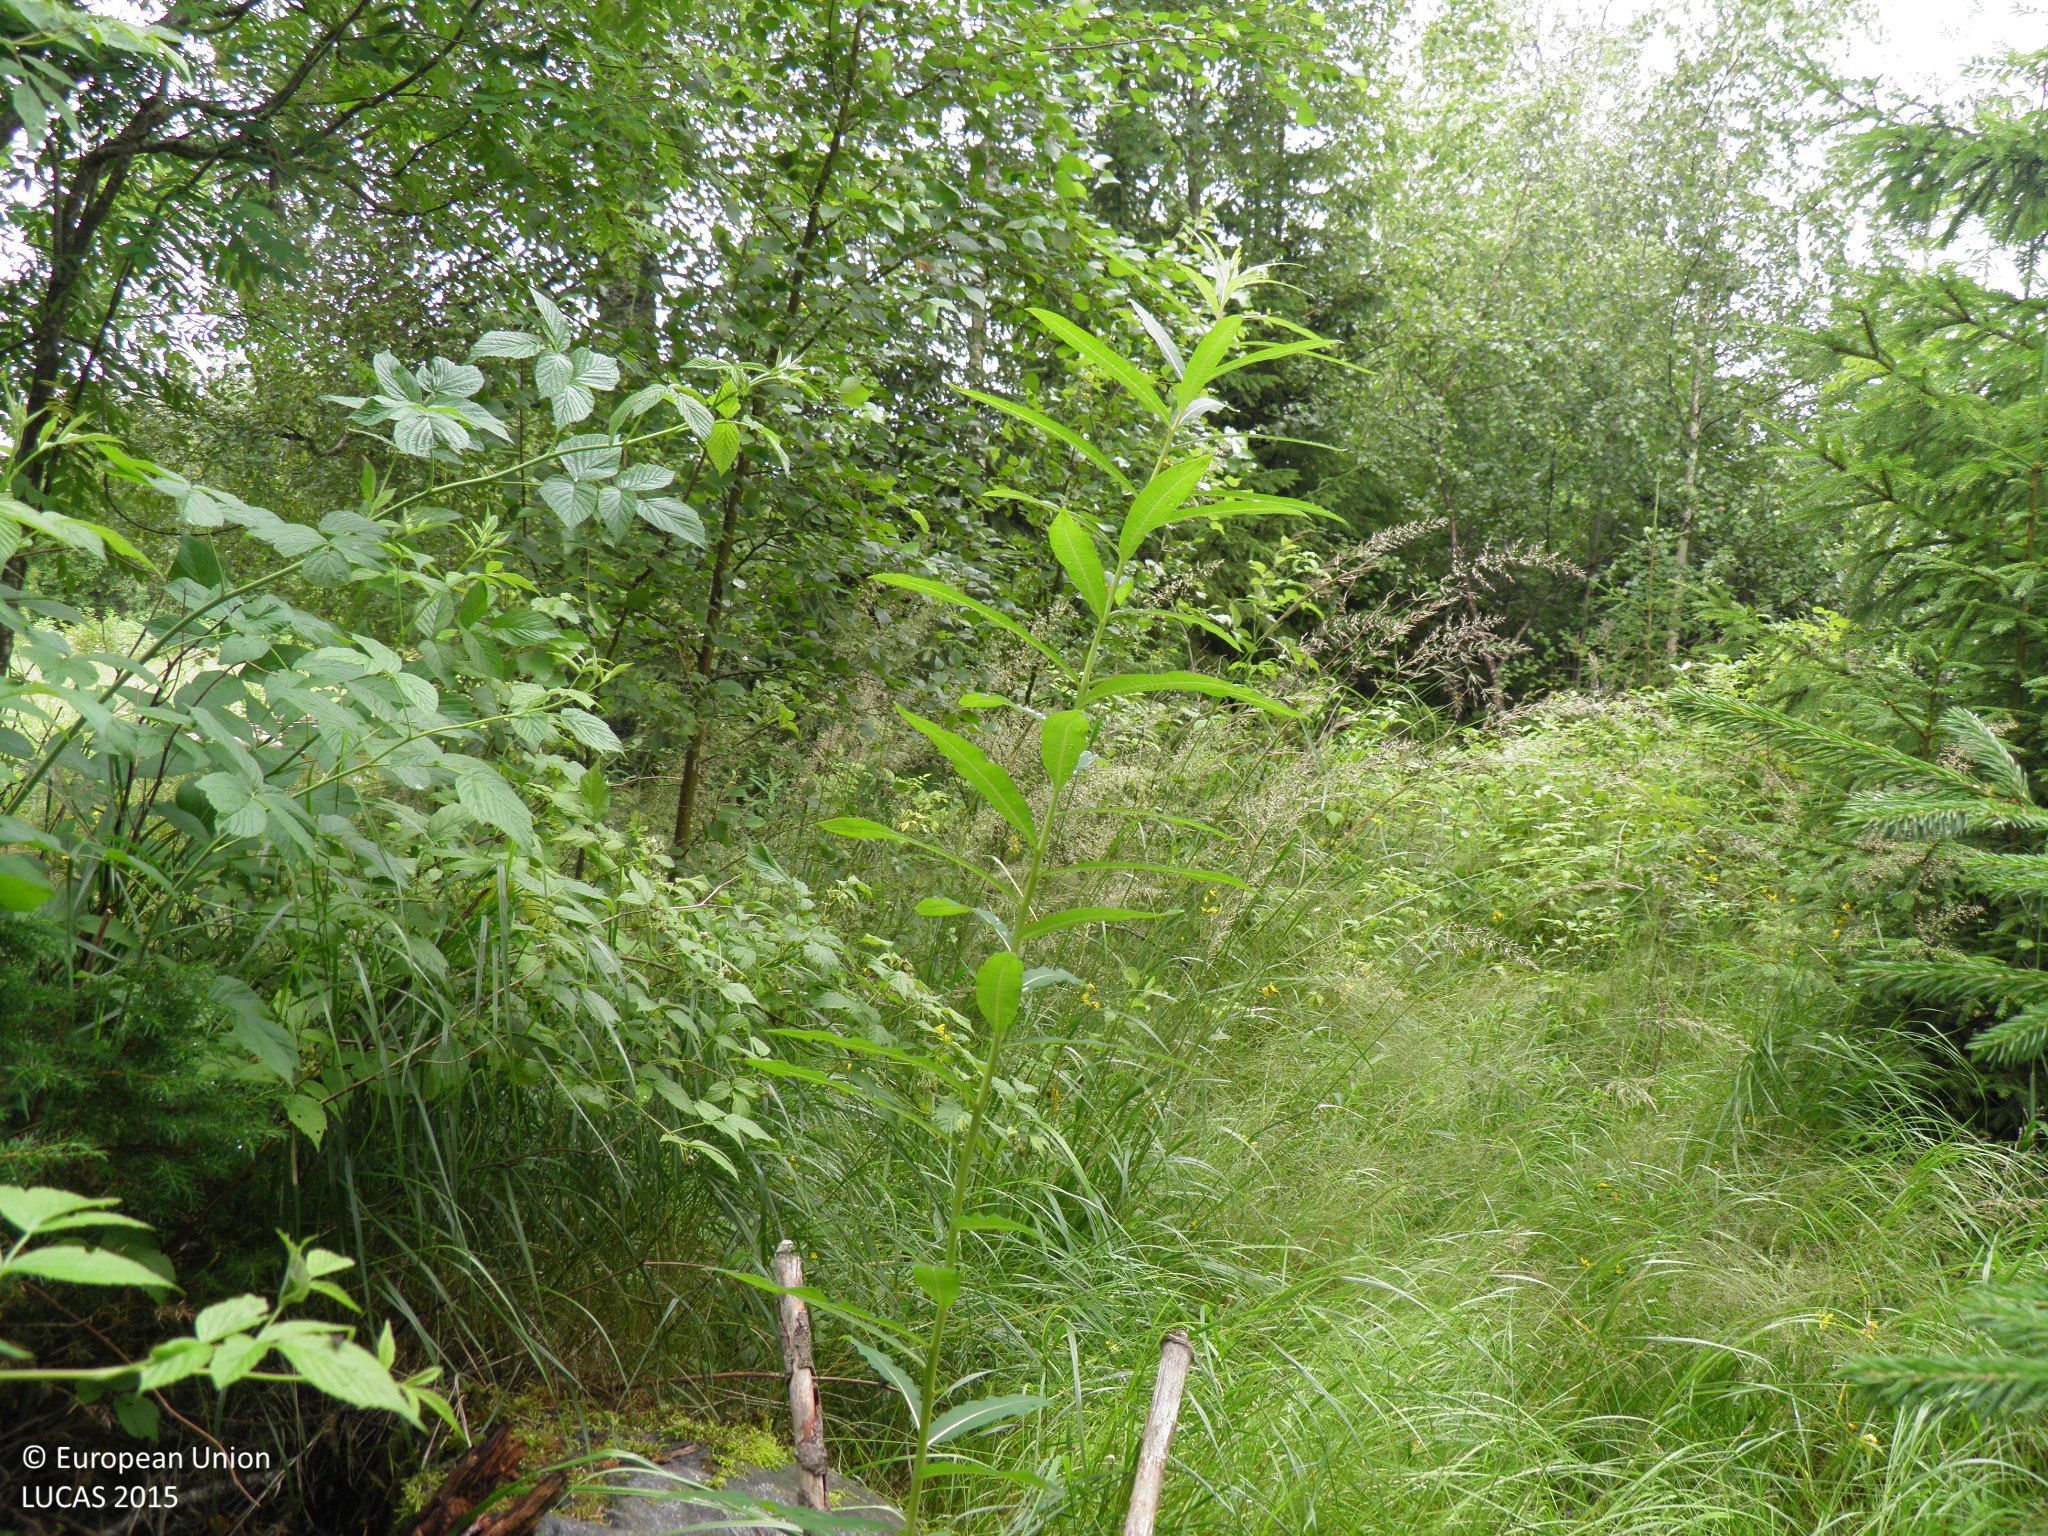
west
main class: Woodland
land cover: Spruce dominated mixed woodland
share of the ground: 50 - 75 %
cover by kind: broadleaved forest trees 40 %, coniferous forest trees 25 %, shrubs 20 %, herbaceous plants 15 %
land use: Forestry
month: July
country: FI
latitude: 60.8917
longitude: 22.8062
